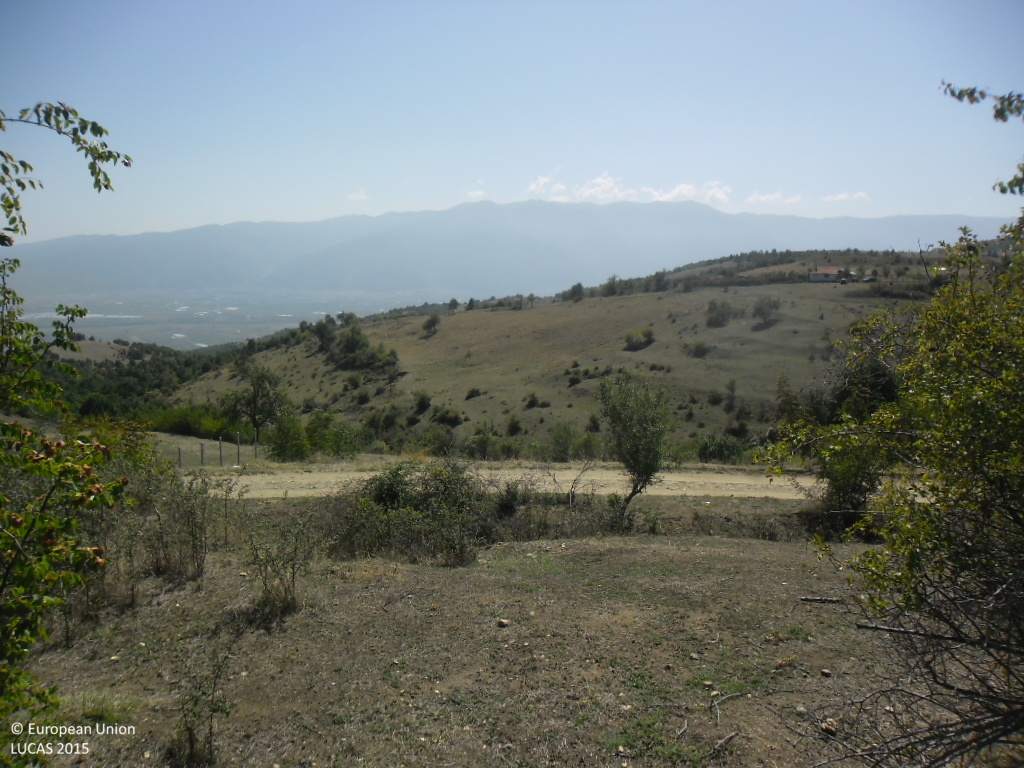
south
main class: Grassland
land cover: Grassland with sparse tree/shrub cover
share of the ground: > 75 %
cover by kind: herbaceous plants 90 %, broadleaved forest trees 5 %, shrubs 5 %
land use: Agriculture (excluding fallow land and kitchen gardens)
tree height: < 5 m
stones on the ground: < 10 %
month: September
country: BG
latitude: 41.4809
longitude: 23.1569
